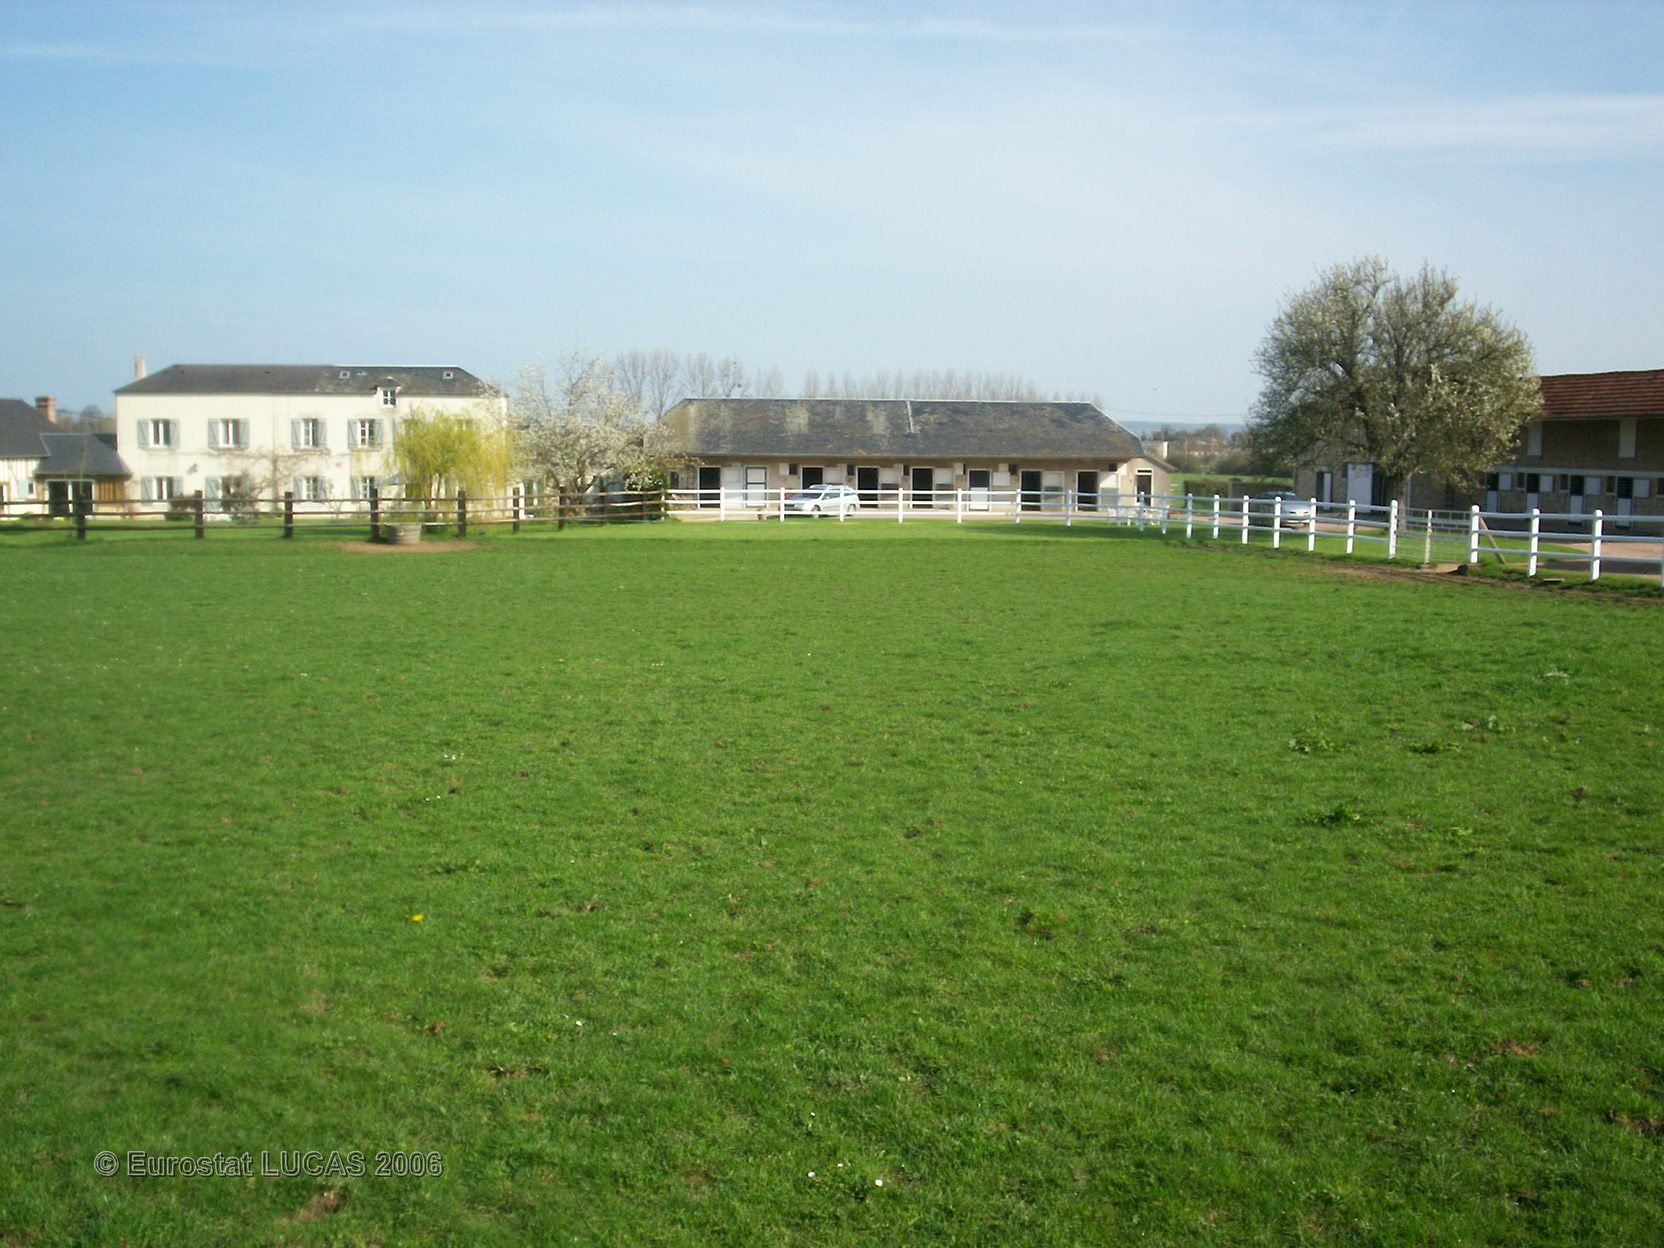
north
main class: Grassland
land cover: Grassland without tree/shrub cover
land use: Agriculture (excluding fallow land and kitchen gardens)
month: April
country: FR
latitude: 49.0720
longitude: -0.0100
